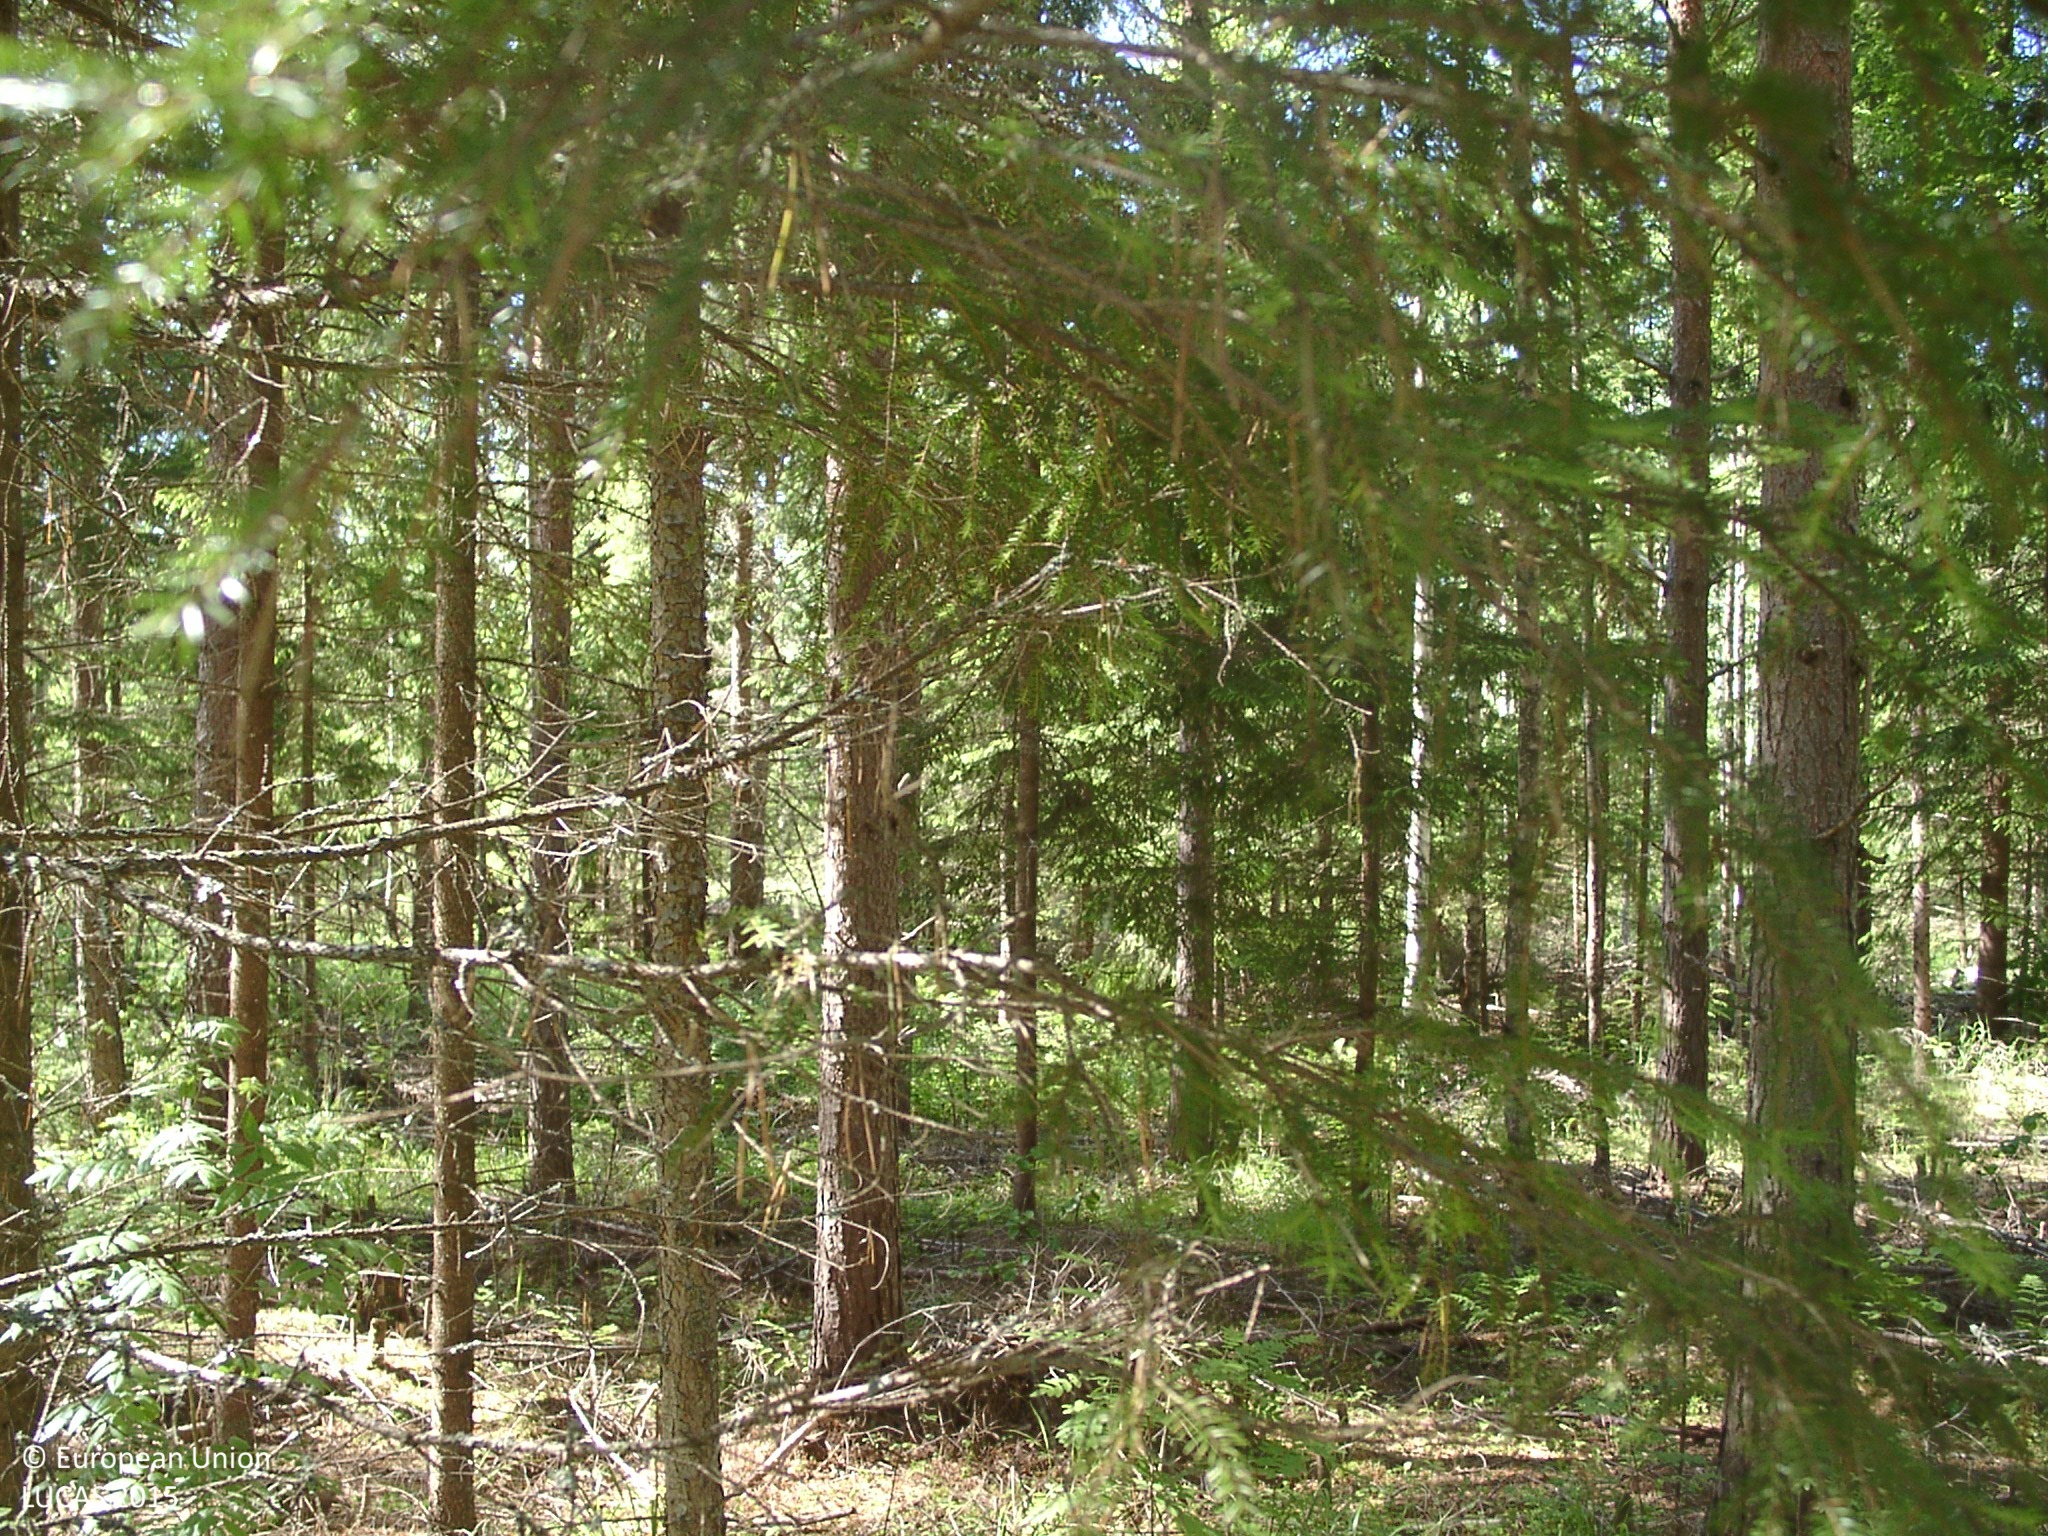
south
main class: Woodland
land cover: Other coniferous woodland
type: boreal forest
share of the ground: 50 - 75 %
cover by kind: coniferous forest trees 60 %, herbaceous plants 20 %, broadleaved forest trees 5 %, shrubs 5 %, lichens and mosses 5 %
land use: Forestry
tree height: > 5 m
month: June
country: FI
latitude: 62.1267
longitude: 25.0408
